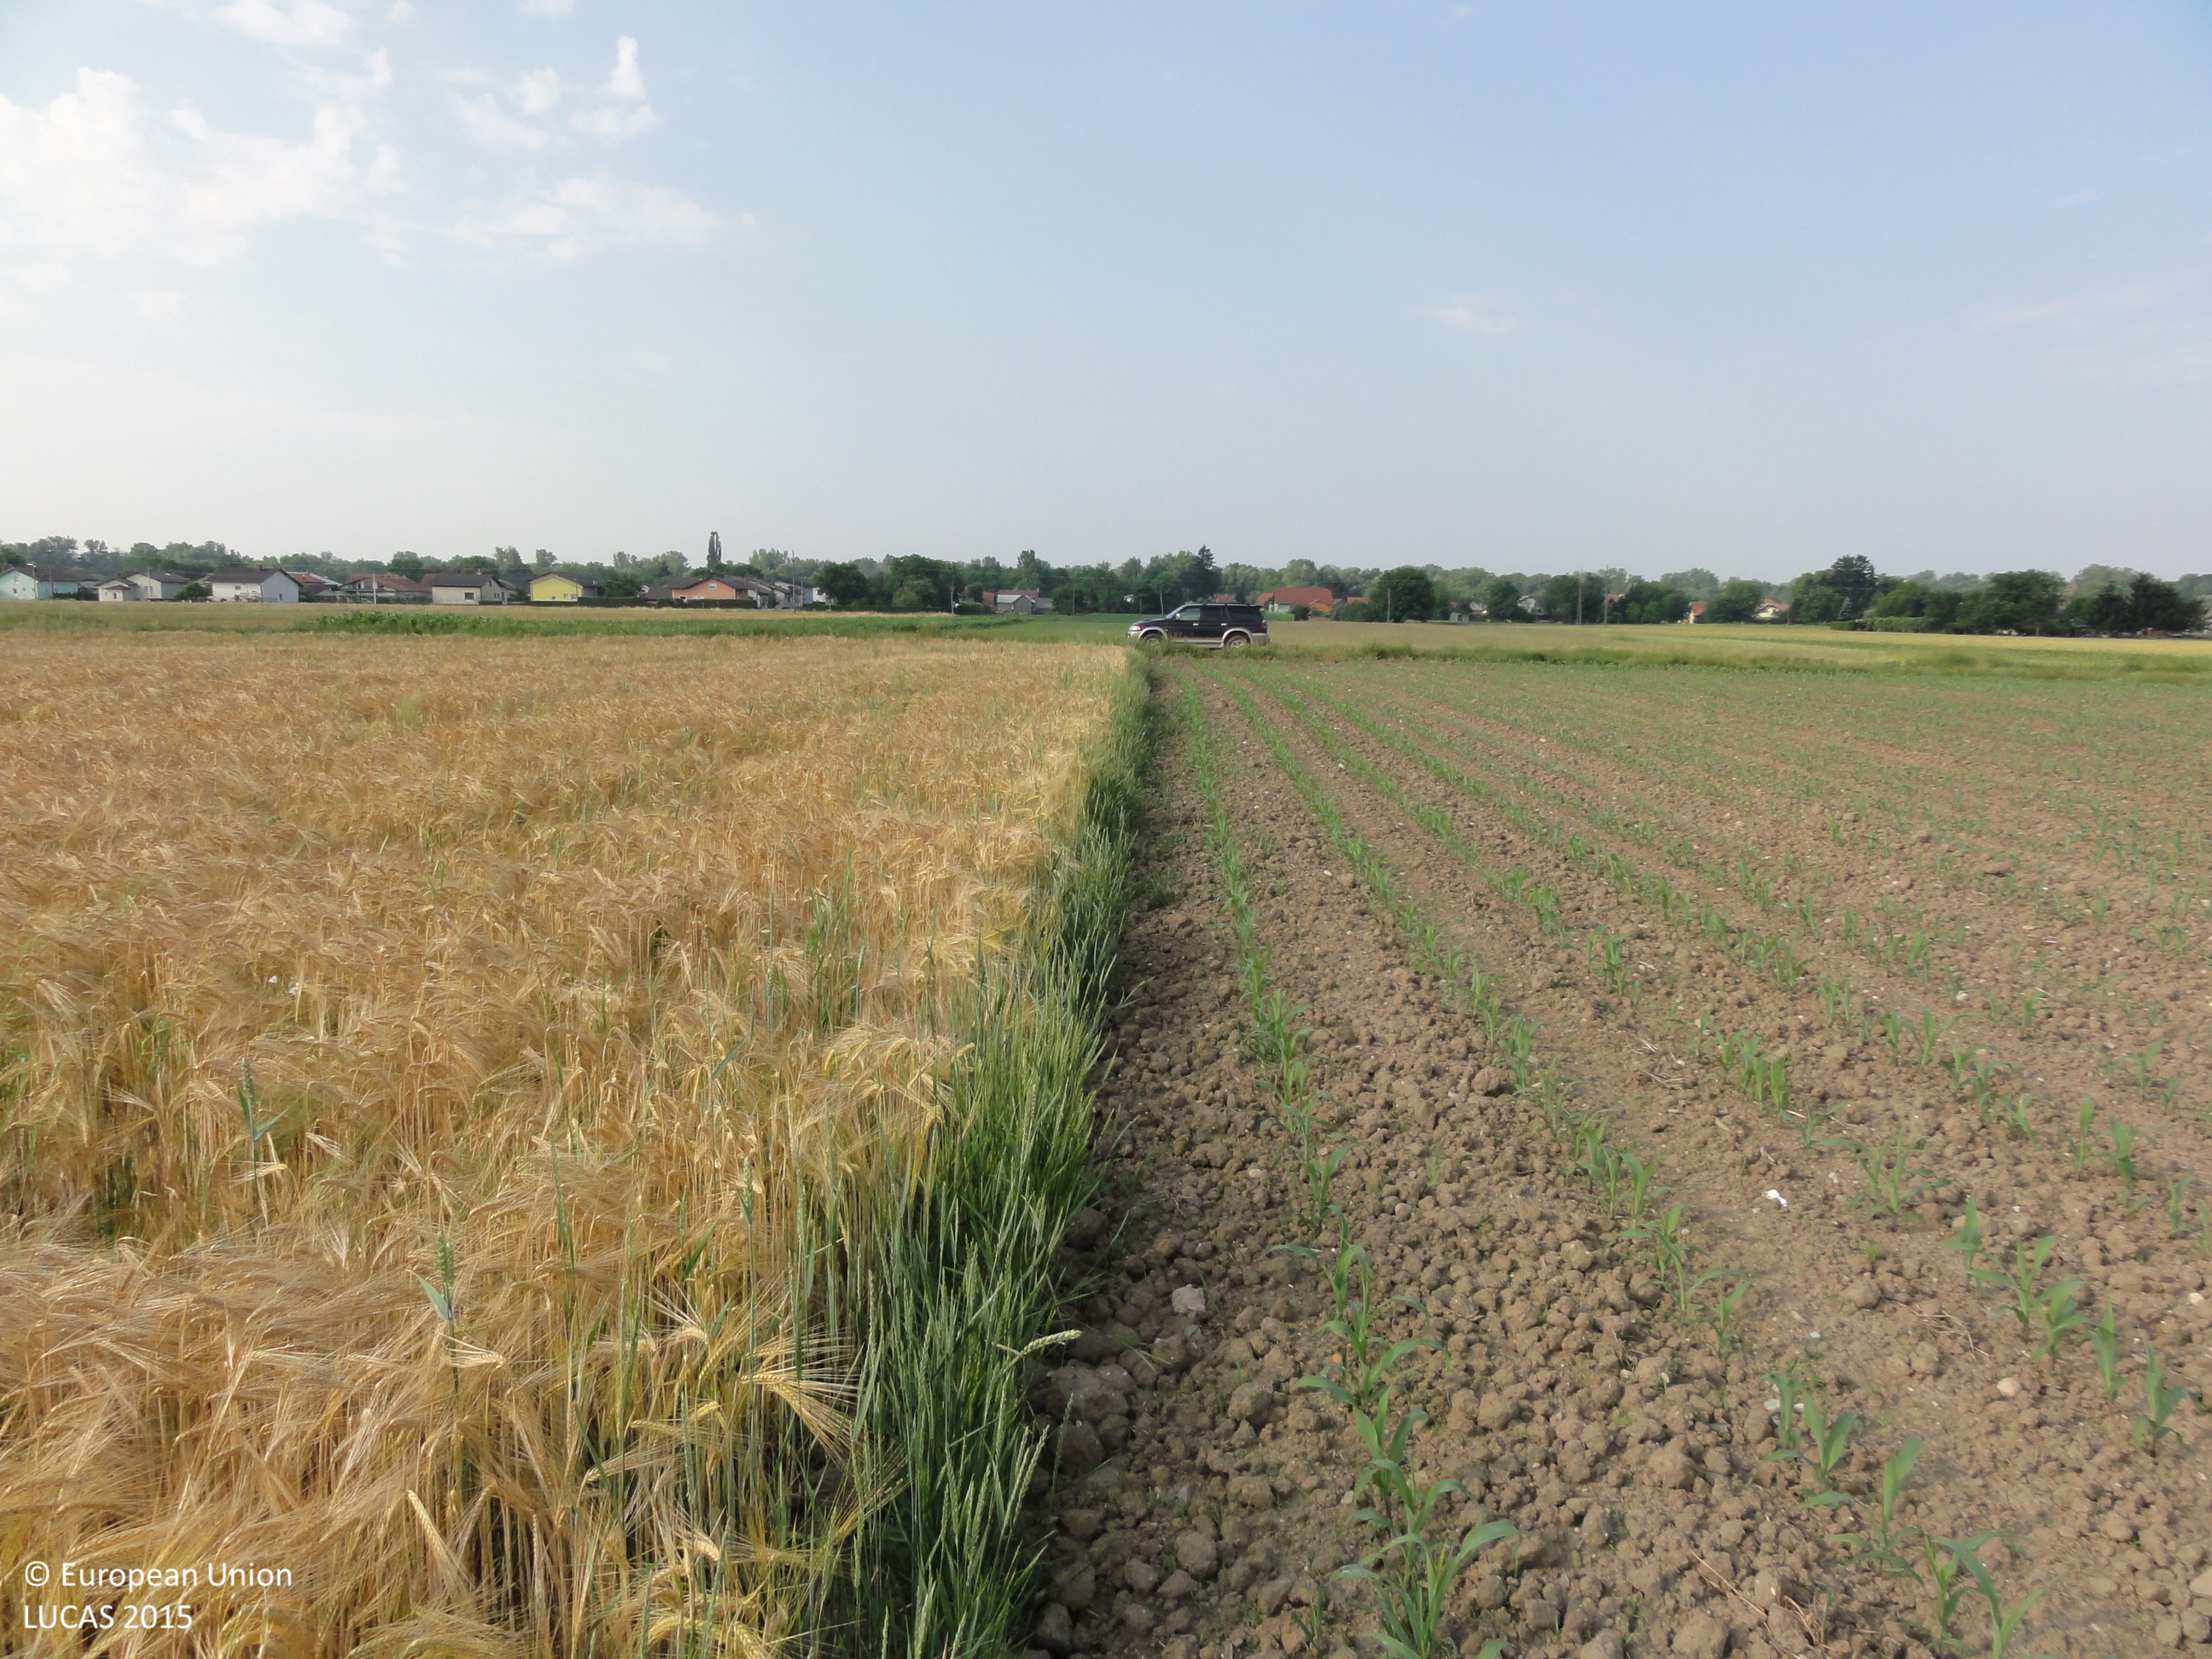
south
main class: Cropland
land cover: Barley
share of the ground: > 75 %
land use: Agriculture (excluding fallow land and kitchen gardens)
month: June
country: SI
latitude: 46.6062
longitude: 16.1758
